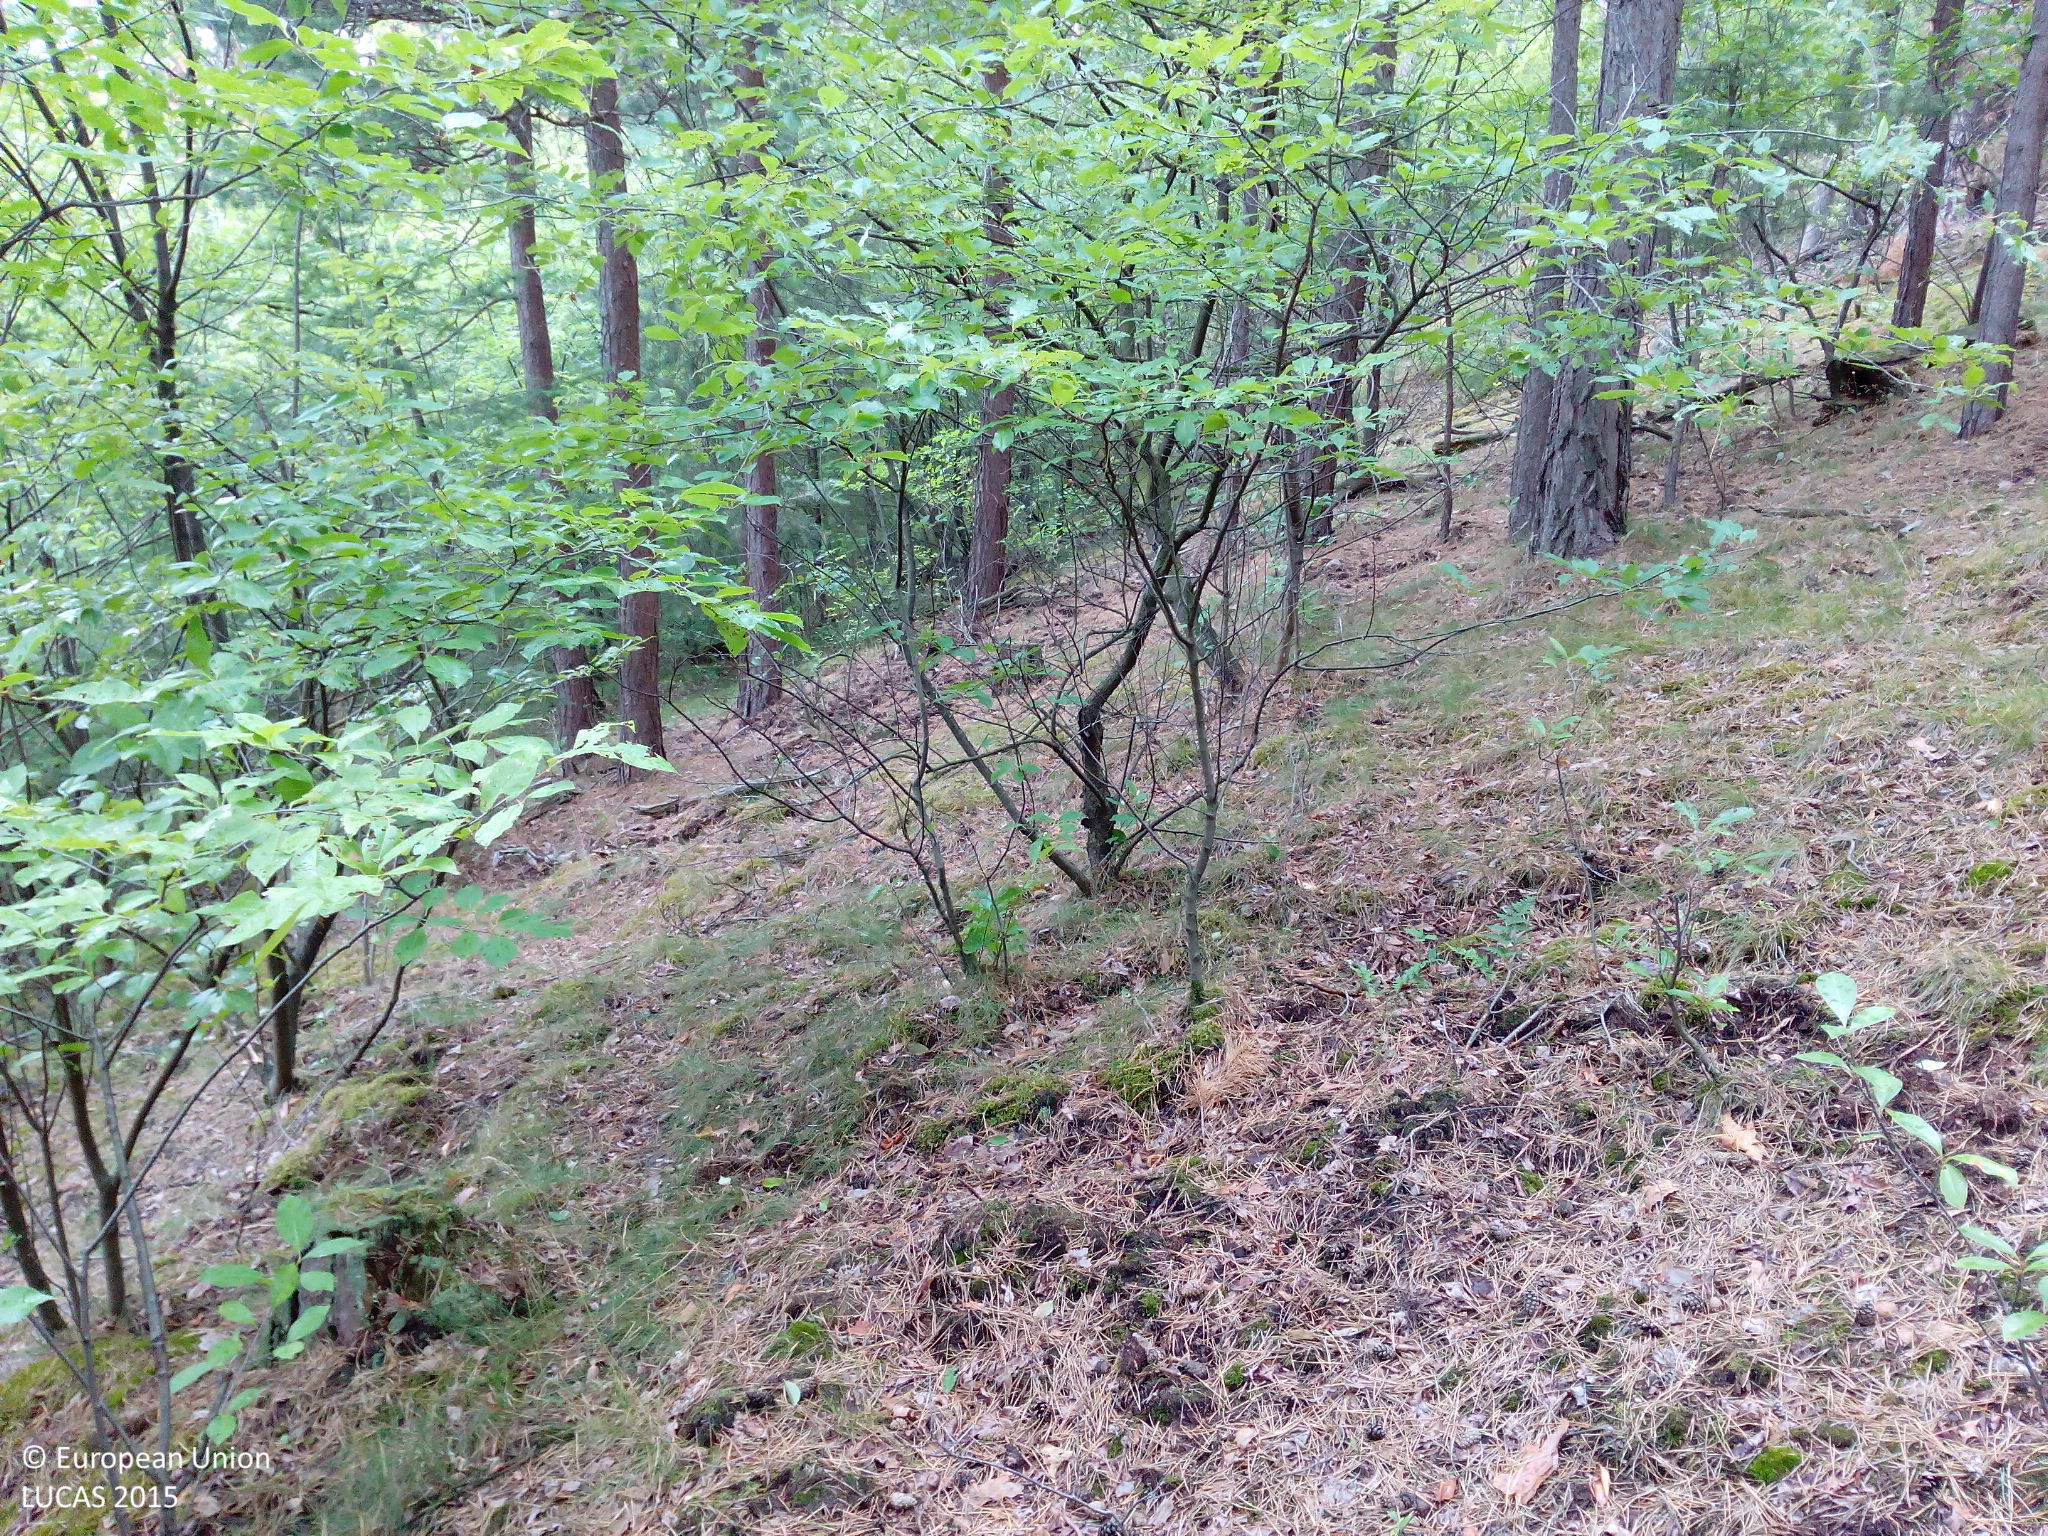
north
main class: Woodland
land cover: Pine dominated mixed woodland
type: hemiboreal forest and nemoral coniferous forest and mixed broadleaved-coniferous forest
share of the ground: > 75 %
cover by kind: coniferous forest trees 65 %, broadleaved forest trees 25 %, lichens and mosses 10 %
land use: Forestry
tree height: > 5 m
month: July
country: DE
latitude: 52.8615
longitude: 13.6392
